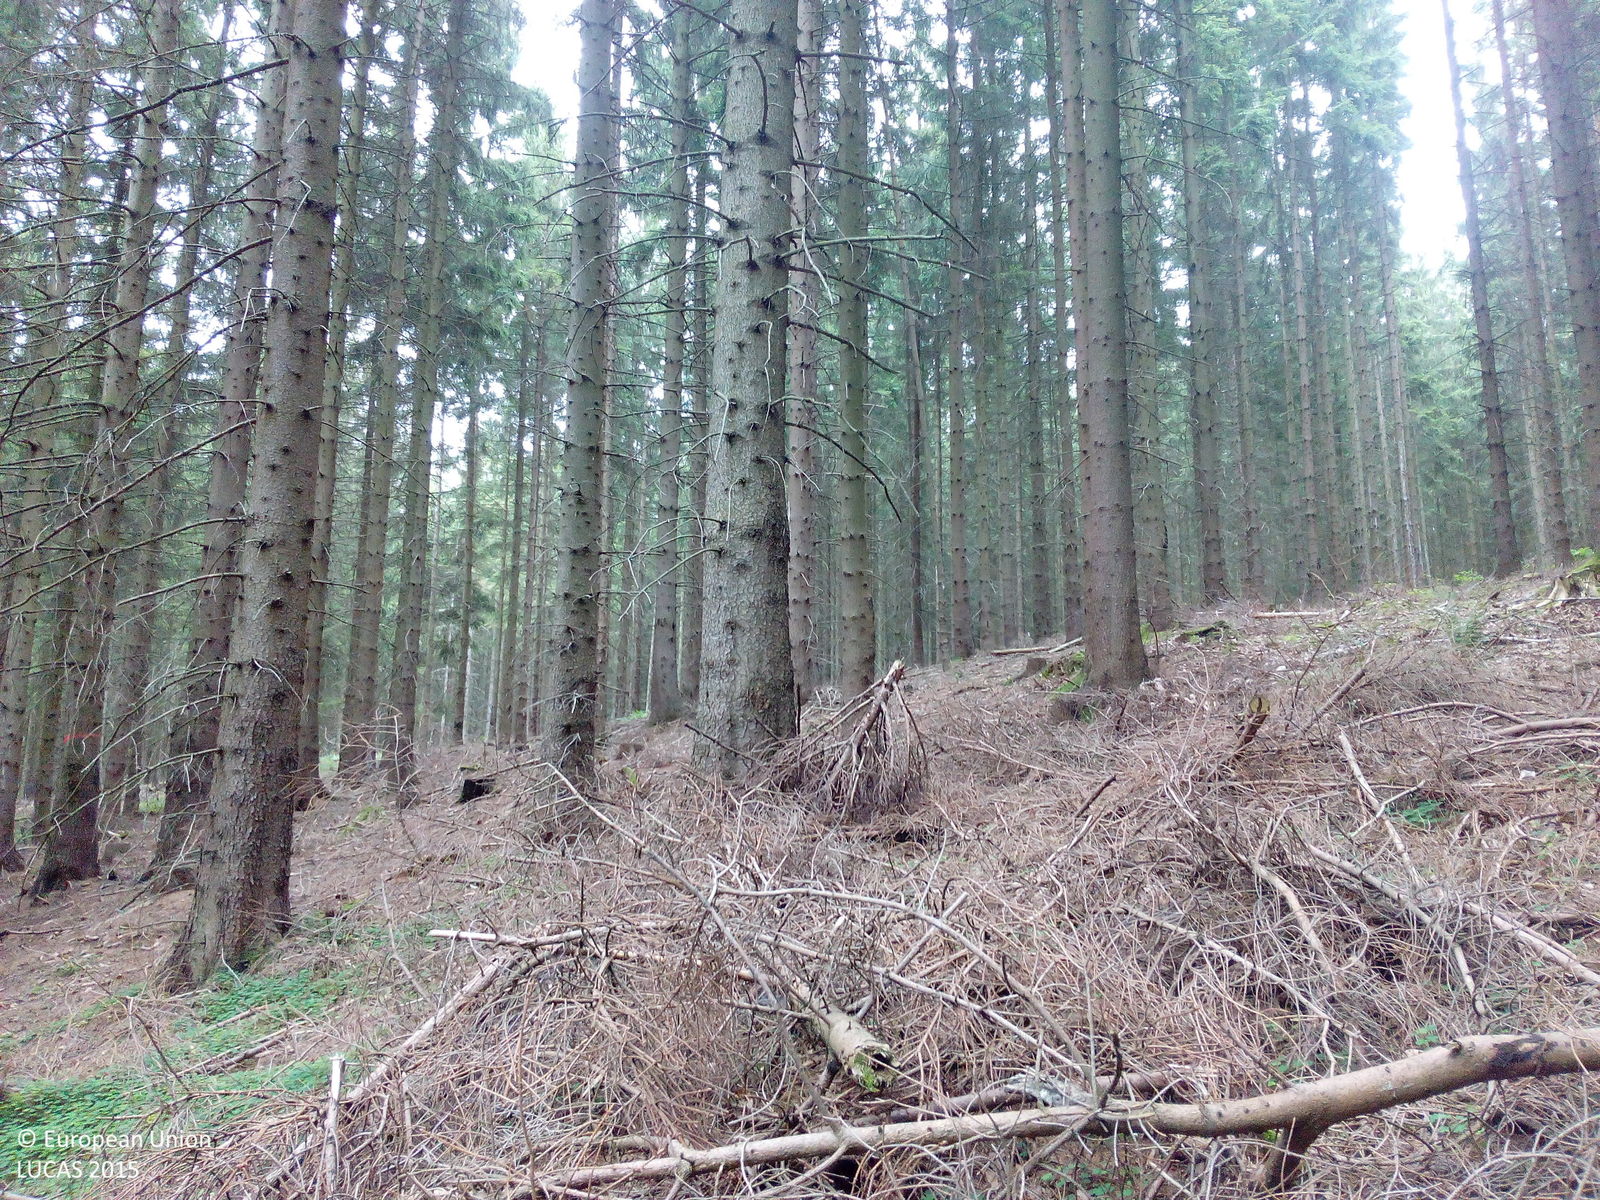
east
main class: Woodland
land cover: Spruce dominated coniferous woodland
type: hemiboreal forest and nemoral coniferous forest and mixed broadleaved-coniferous forest
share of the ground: > 75 %
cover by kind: coniferous forest trees 80 %, herbaceous plants 10 %, lichens and mosses 10 %
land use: Forestry
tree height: > 5 m
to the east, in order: Spruce dominated coniferous woodland; Tracks; Spruce dominated coniferous woodland; Rivers and streams; Spruce dominated coniferous woodland; Tracks; Spruce dominated coniferous woodland
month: August
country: DE
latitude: 51.7074
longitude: 11.0850
